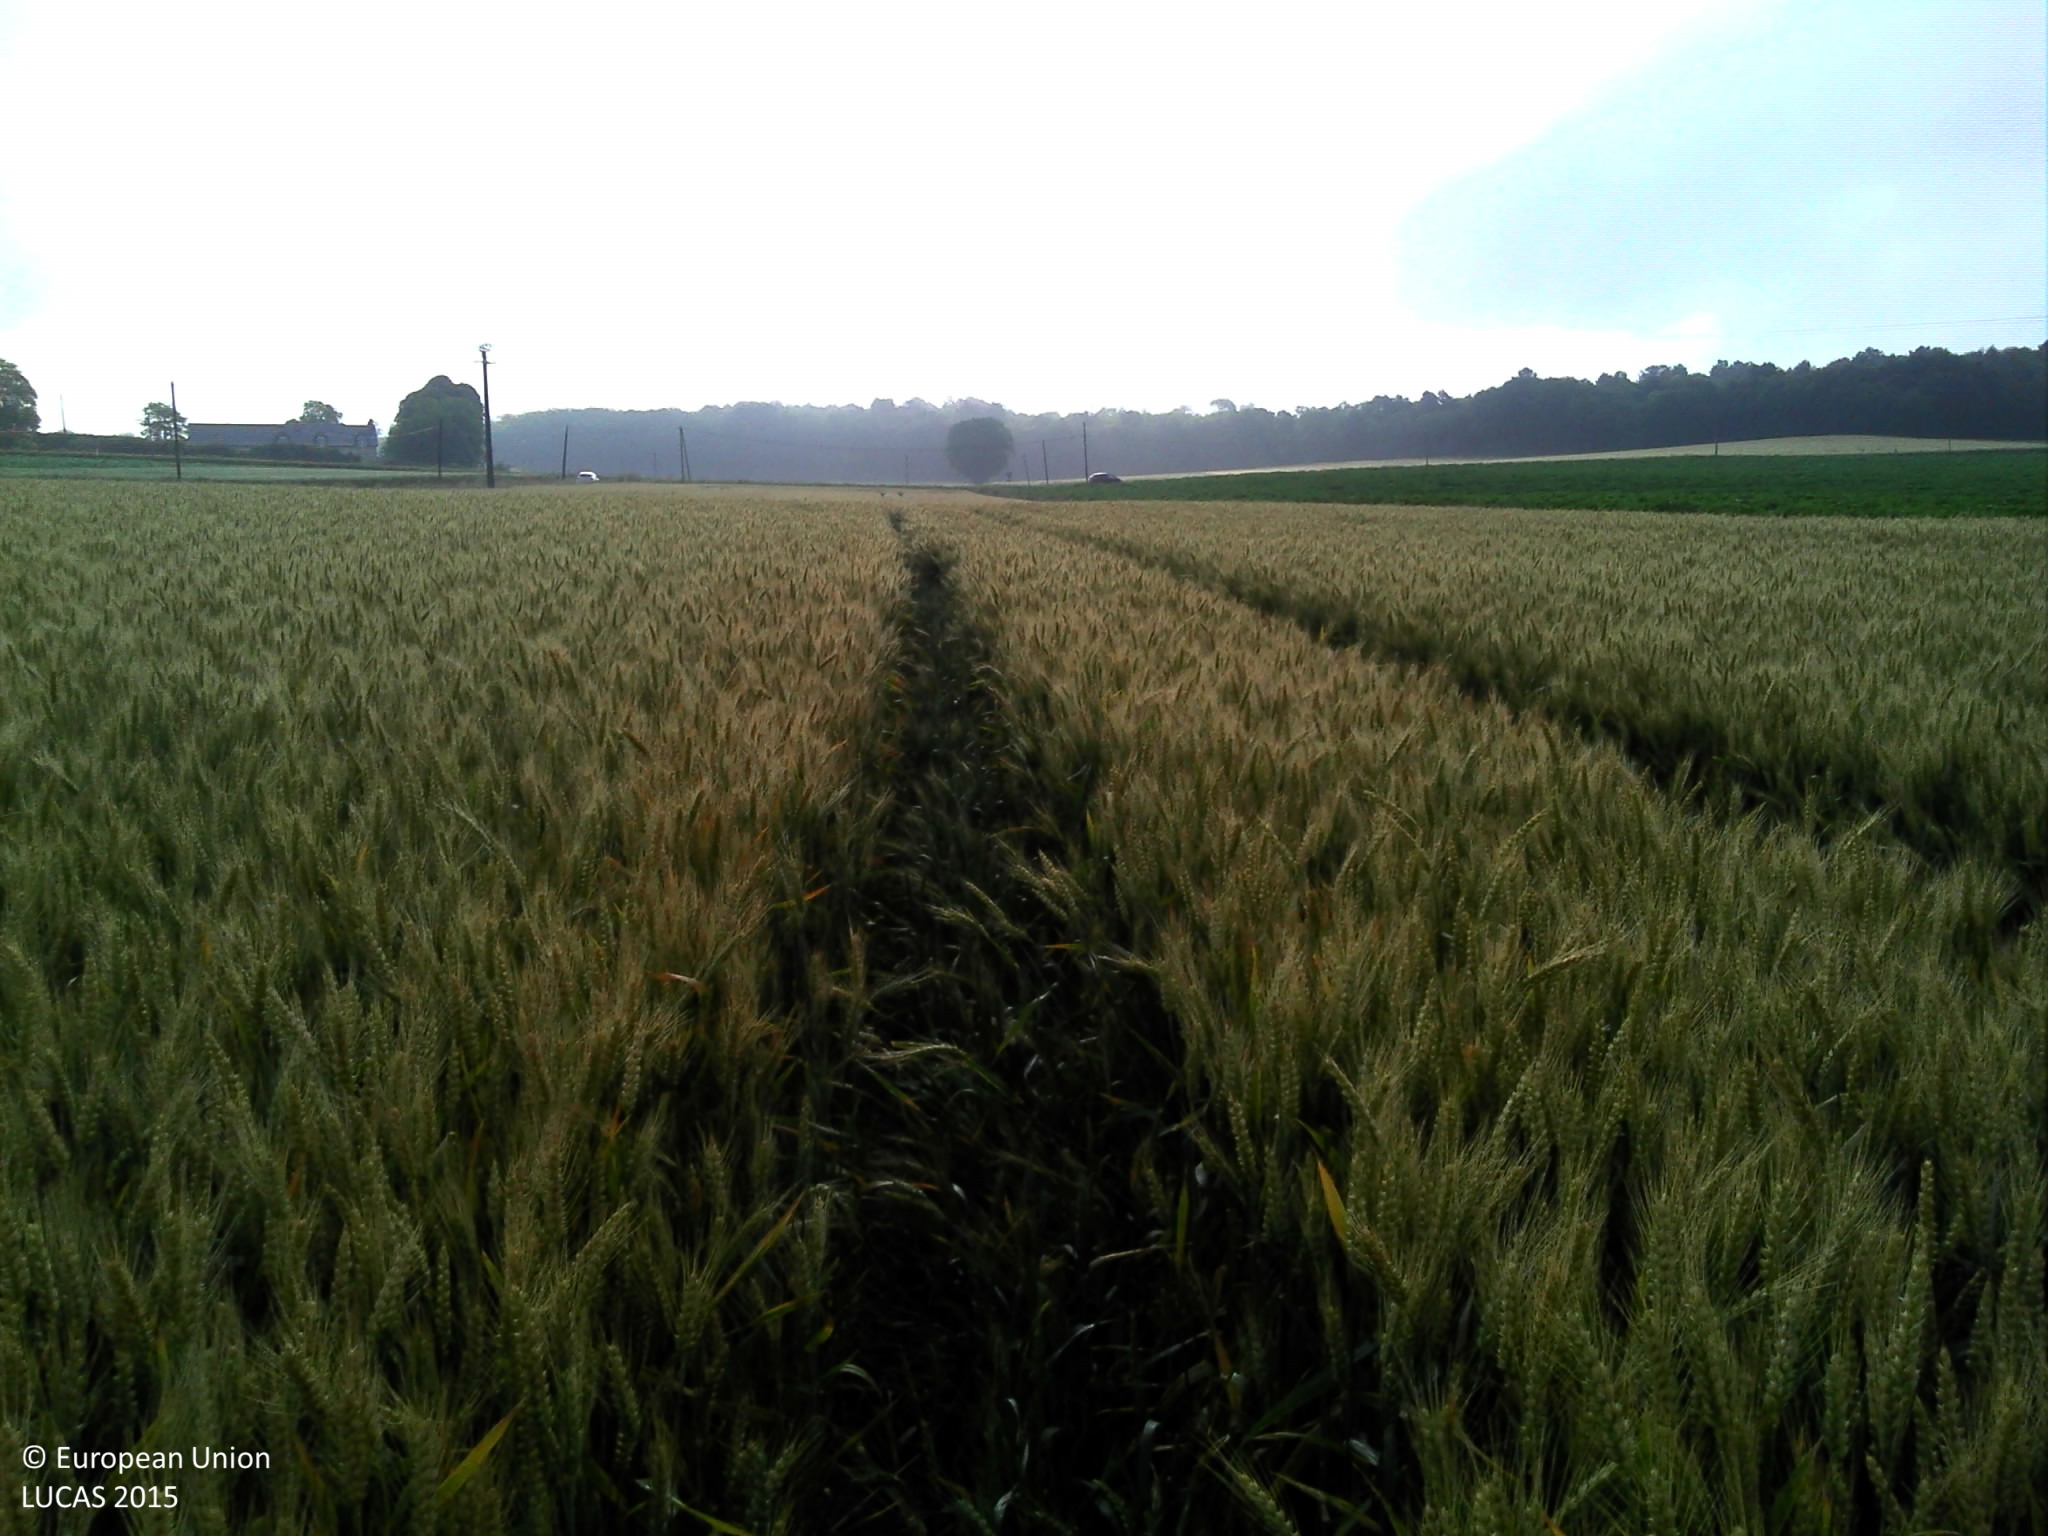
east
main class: Cropland
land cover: Common wheat
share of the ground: > 75 %
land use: Agriculture (excluding fallow land and kitchen gardens)
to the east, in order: Common wheat; Grass margins; Ditches and canals; Grass margins; Sunflower; Electric lines; Grass margins; Paved roads, cycling and walking lanes; Grass margins; Common wheat
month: June
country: FR
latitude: 46.8853
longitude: 0.4664
